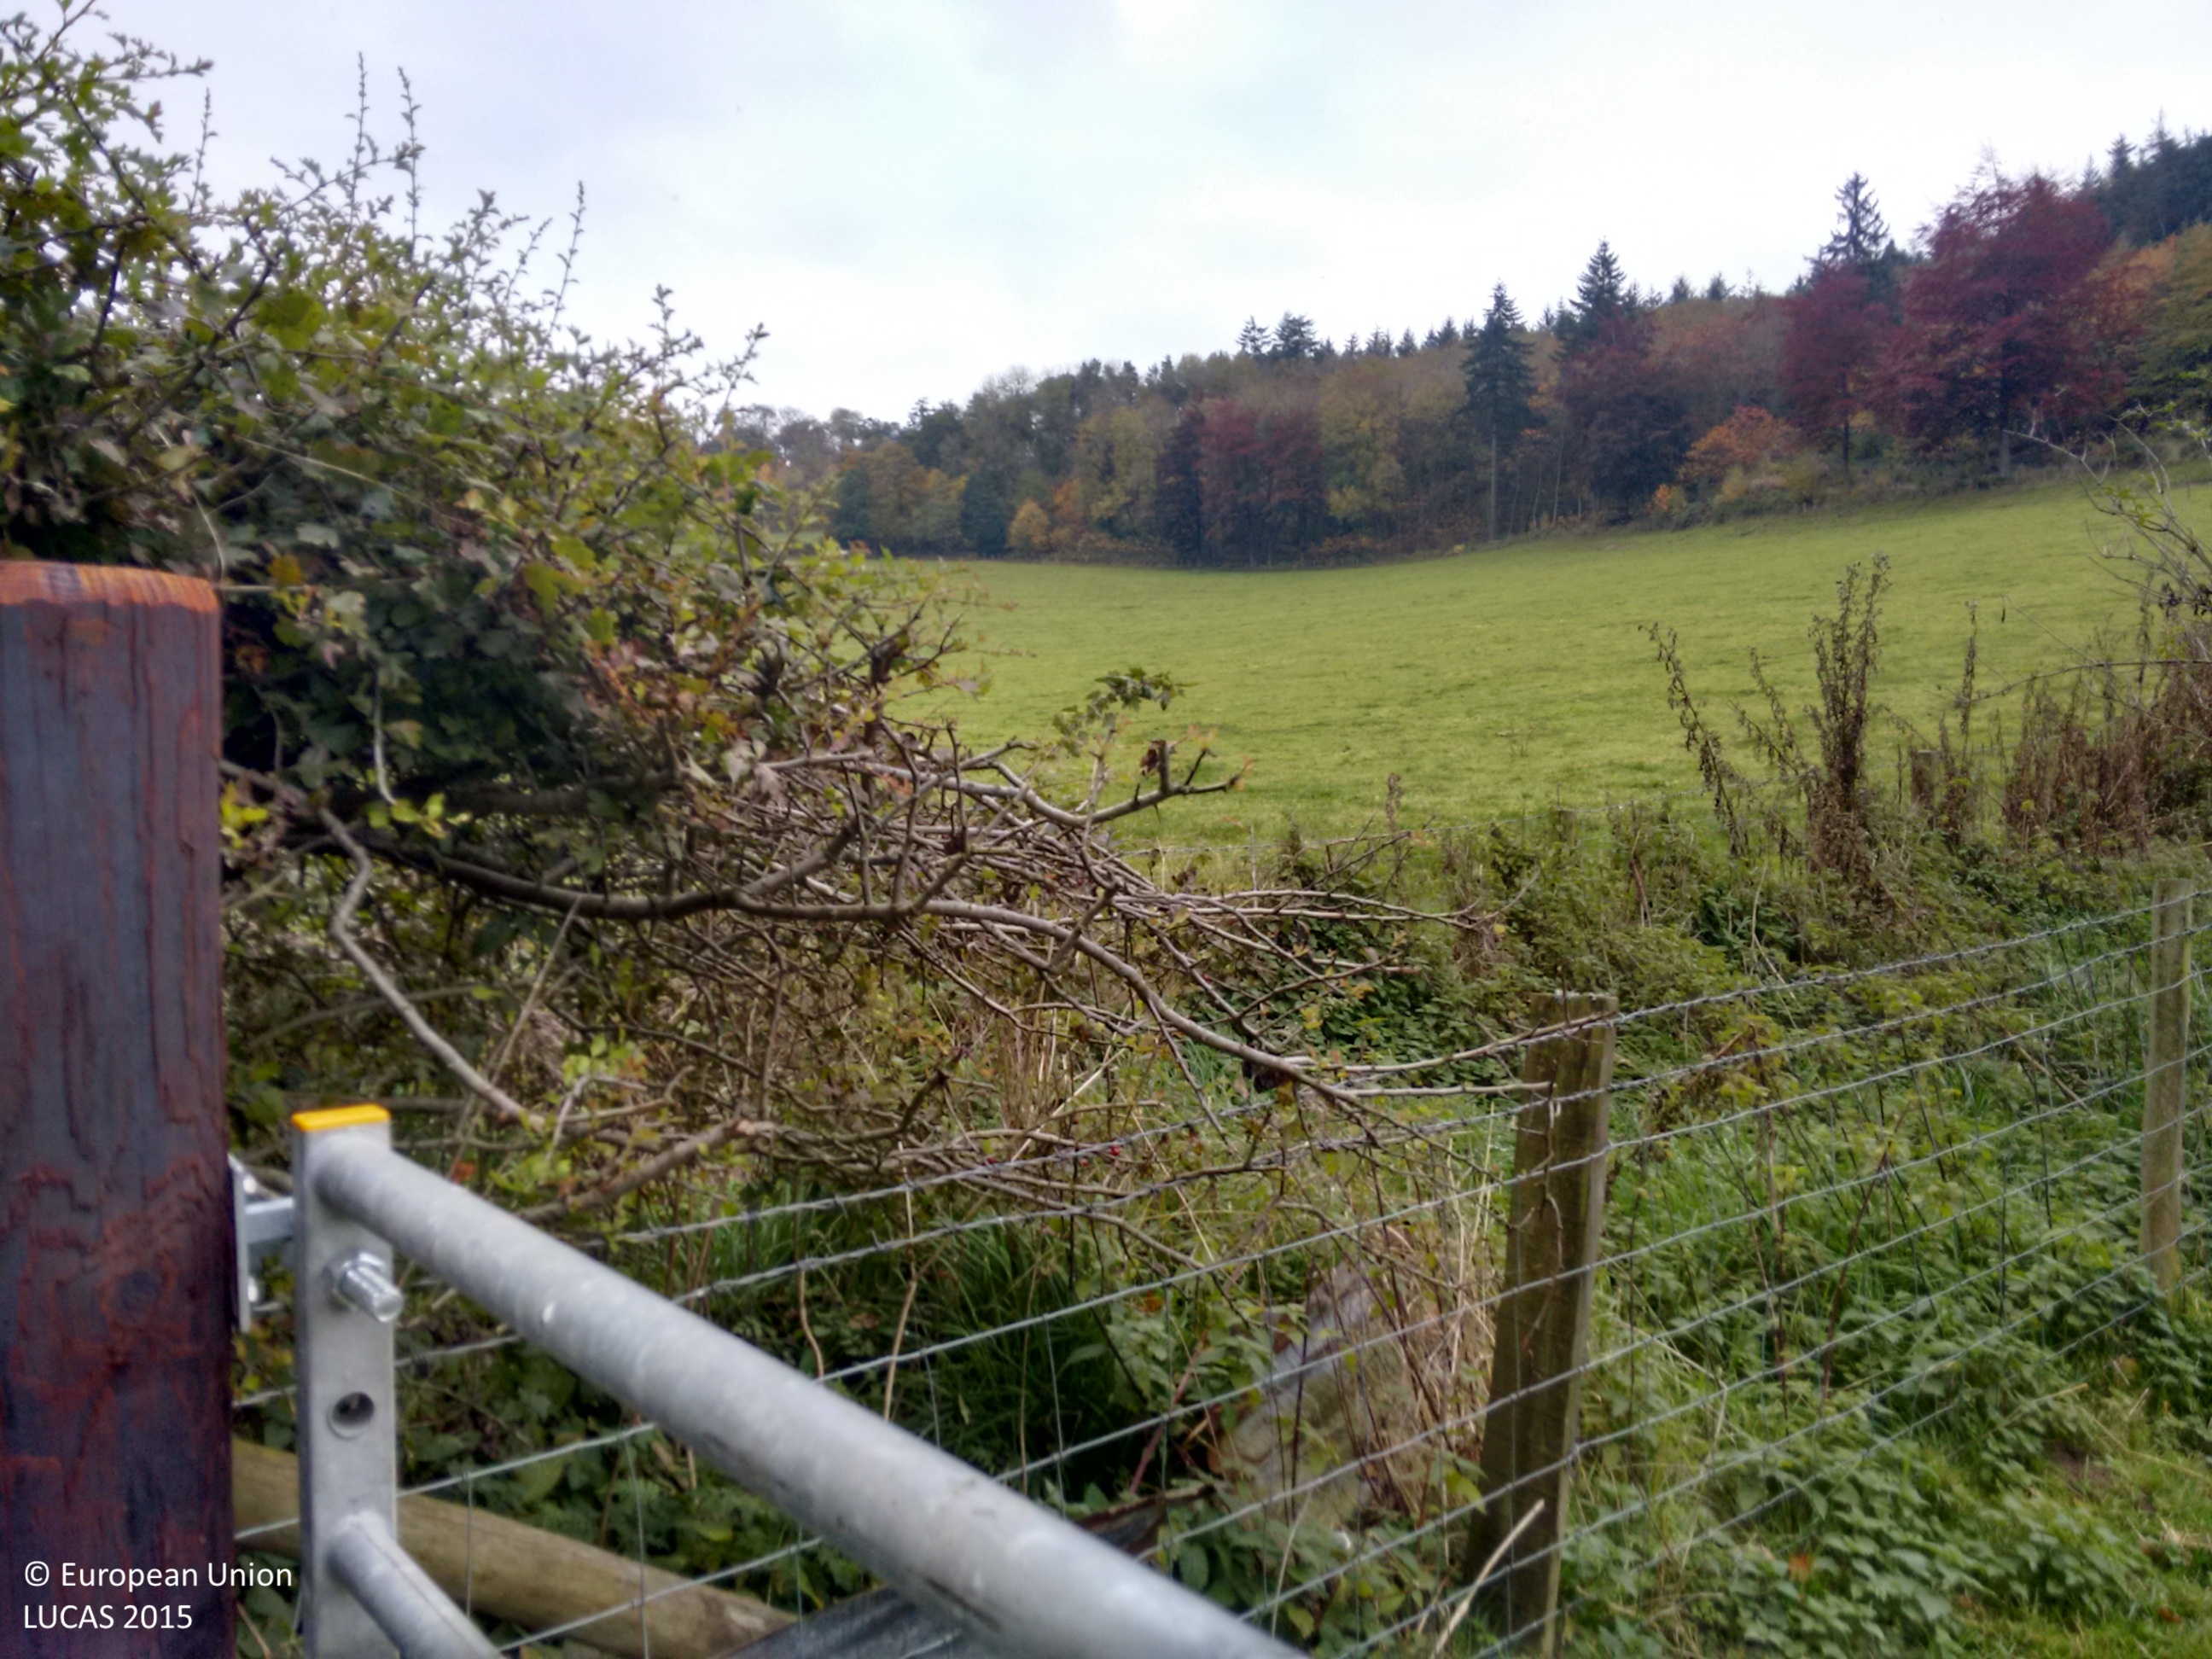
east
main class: Grassland
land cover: Grassland without tree/shrub cover
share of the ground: > 75 %
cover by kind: herbaceous plants 100 %
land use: Agriculture (excluding fallow land and kitchen gardens)
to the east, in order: Grassland without tree/shrub cover; Fences; Managed hedges; Fences; Grassland without tree/shrub cover; Fences; Broadleaved woodland; Spruce dominated coniferous woodland
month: October
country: GB
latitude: 52.4669
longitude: -2.7741
